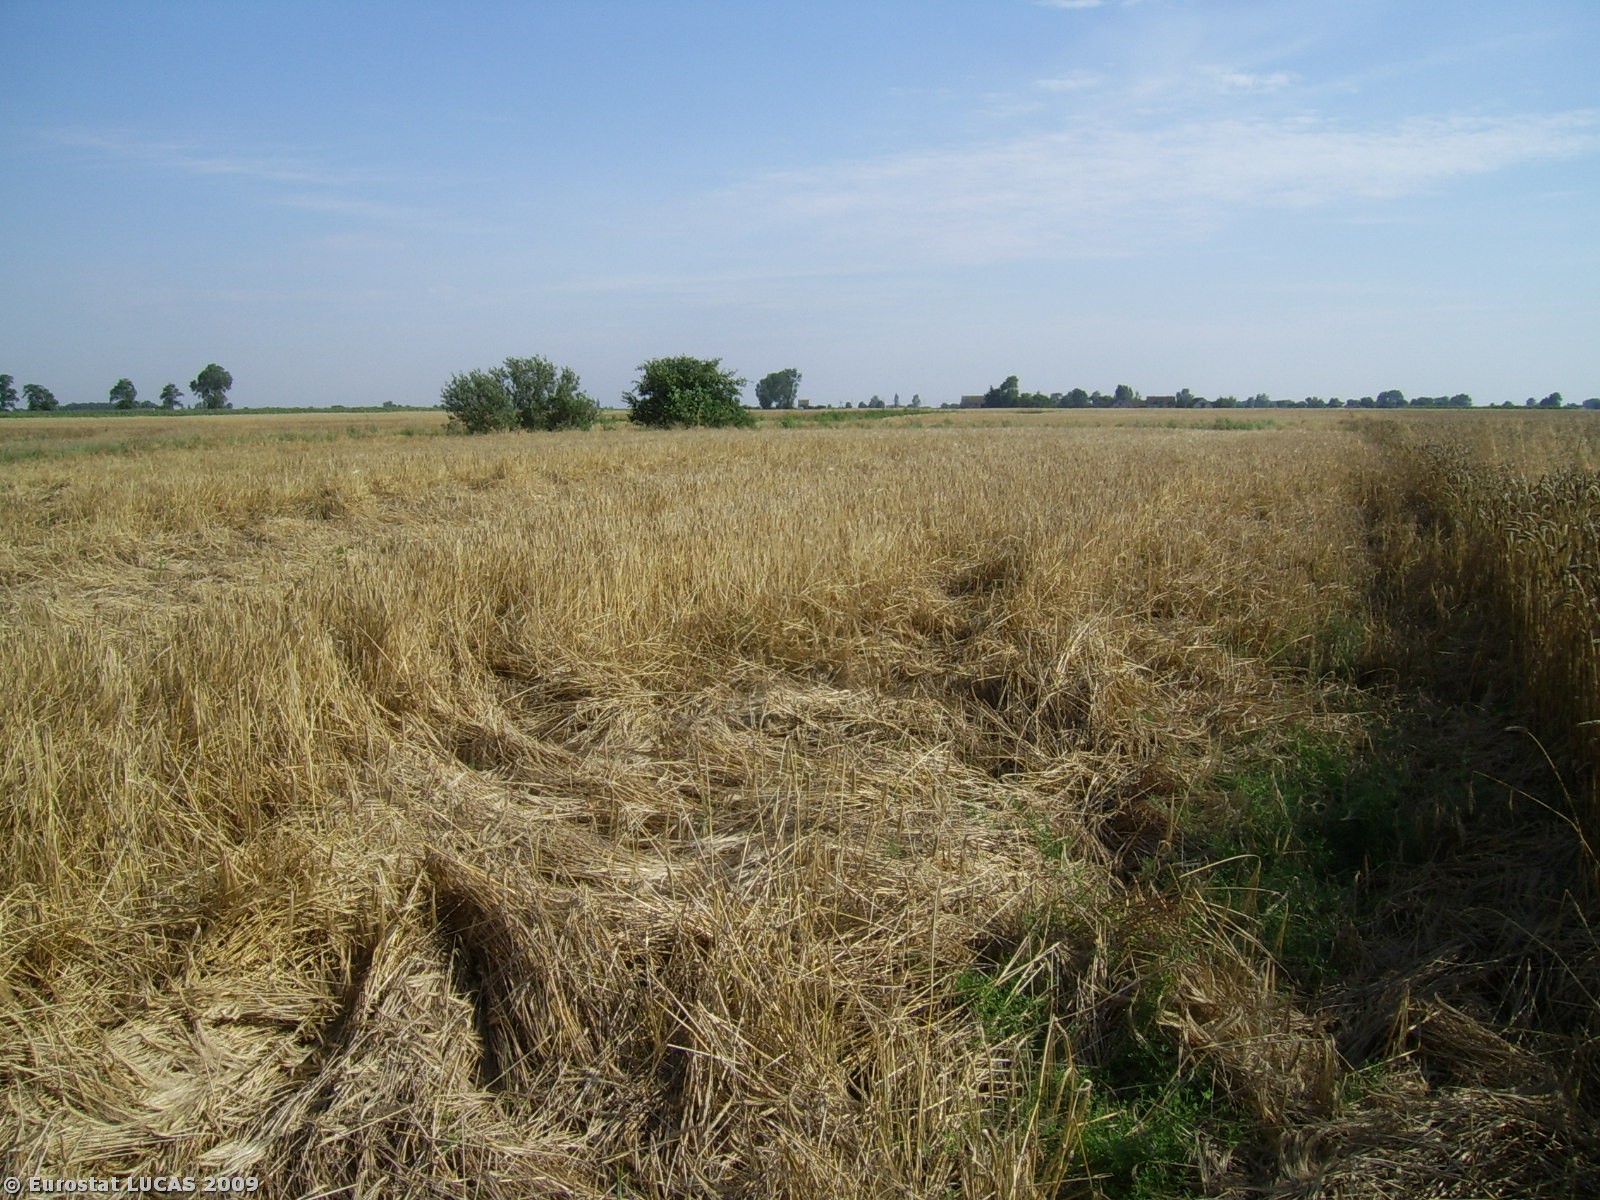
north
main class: Cropland
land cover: Common wheat
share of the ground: < 10 %
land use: Agriculture (excluding fallow land and kitchen gardens)
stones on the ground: < 10 %
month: July
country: PL
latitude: 52.6567
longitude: 18.6686
